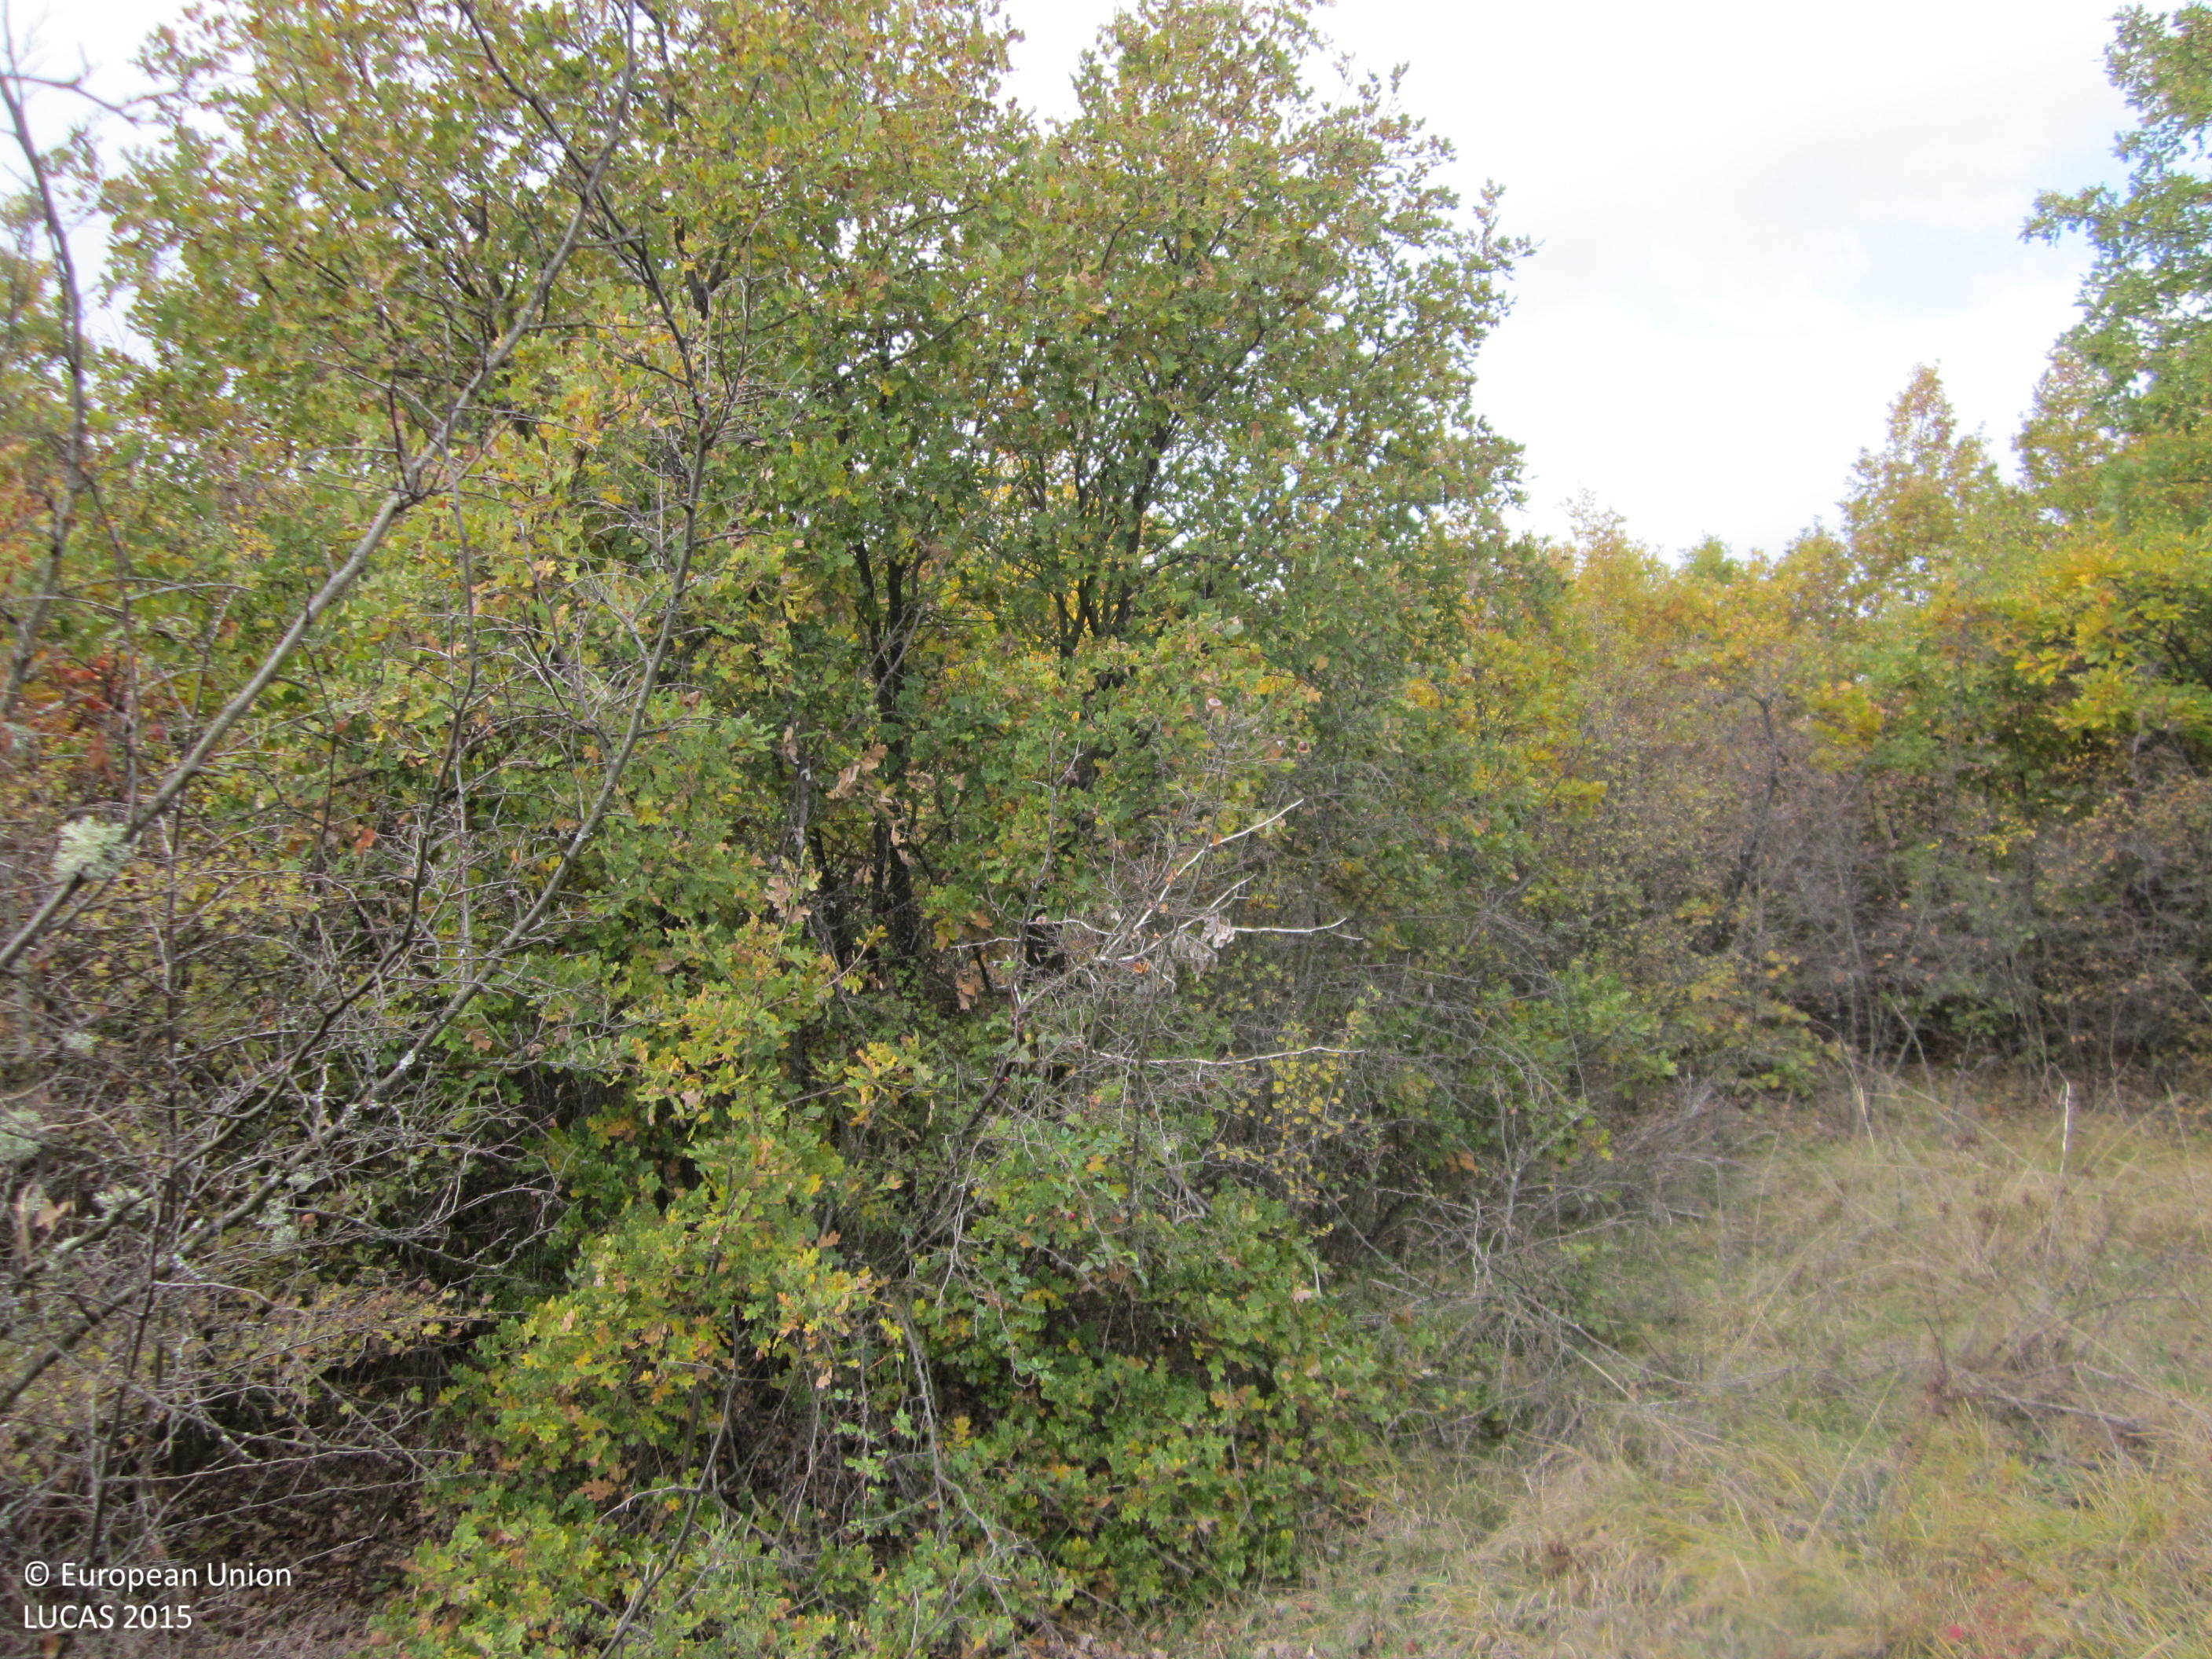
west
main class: Woodland
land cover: Broadleaved woodland
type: mesophytic deciduous forest
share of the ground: > 75 %
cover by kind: broadleaved forest trees 90 %, shrubs 5 %, unconsolidated bare surface 5 %
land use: Forestry
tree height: > 5 m
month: November
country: BG
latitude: 42.5594
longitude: 24.8570
